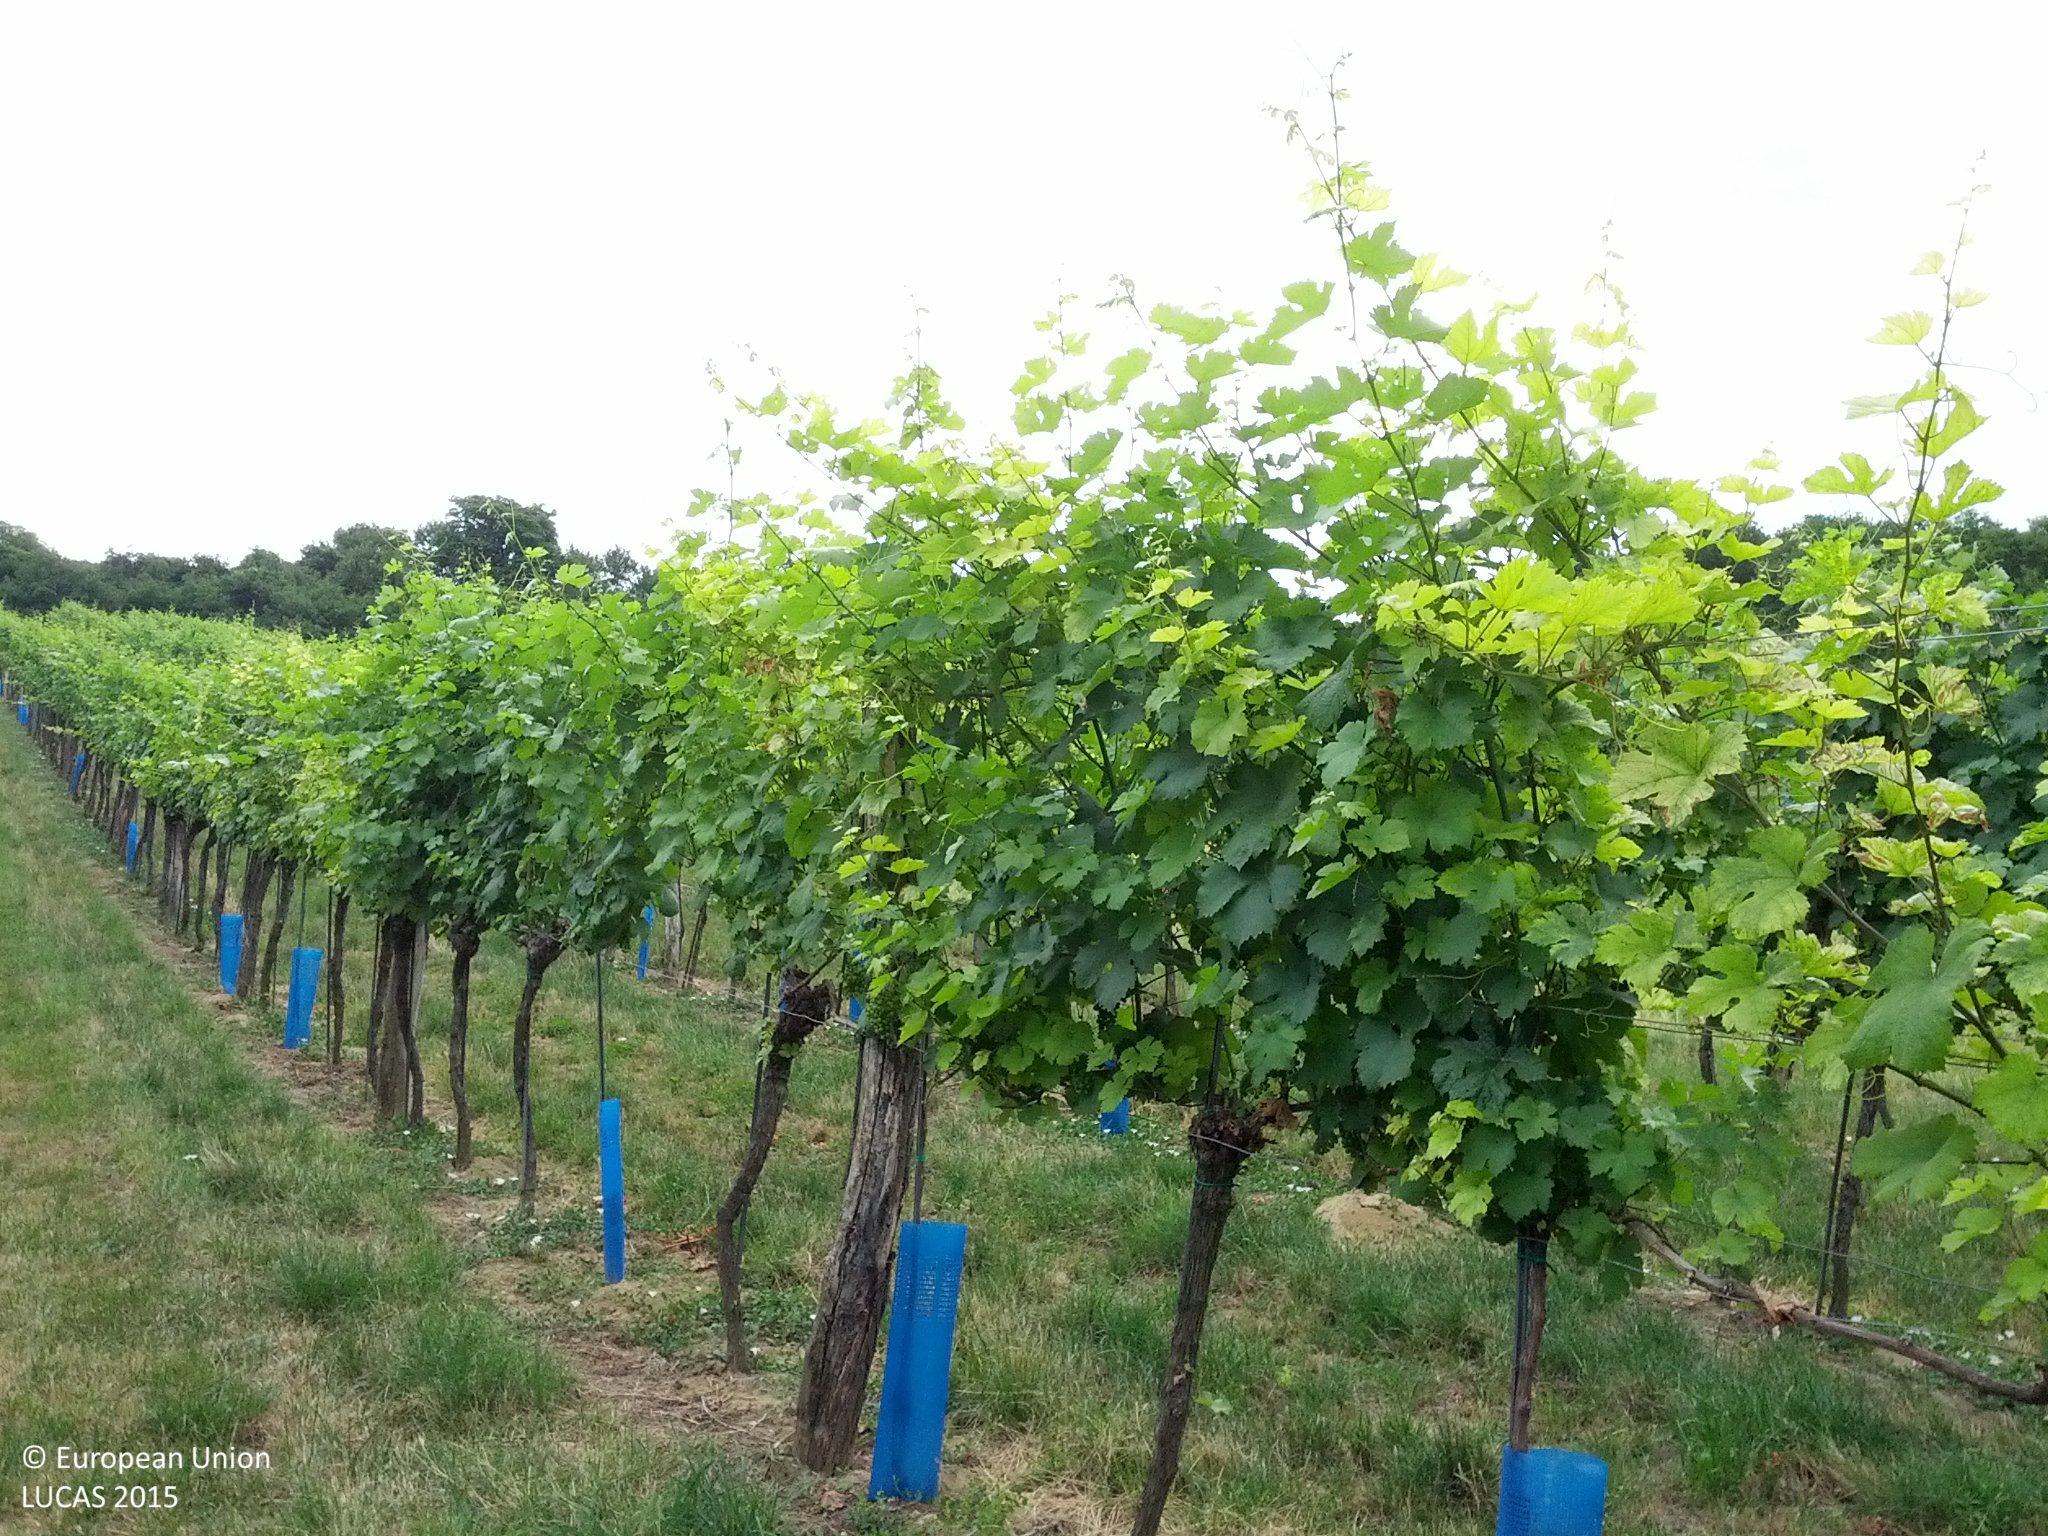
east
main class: Cropland
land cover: Vineyards
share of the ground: 50 - 75 %
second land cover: Grassland without tree/shrub cover
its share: 50 - 75 %
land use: Agriculture (excluding fallow land and kitchen gardens)
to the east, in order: Vineyards; Grassland without tree/shrub cover; Vineyards; Tracks; Broadleaved woodland; Grassland without tree/shrub cover; Common wheat
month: July
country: AT
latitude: 48.5037
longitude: 16.1359
